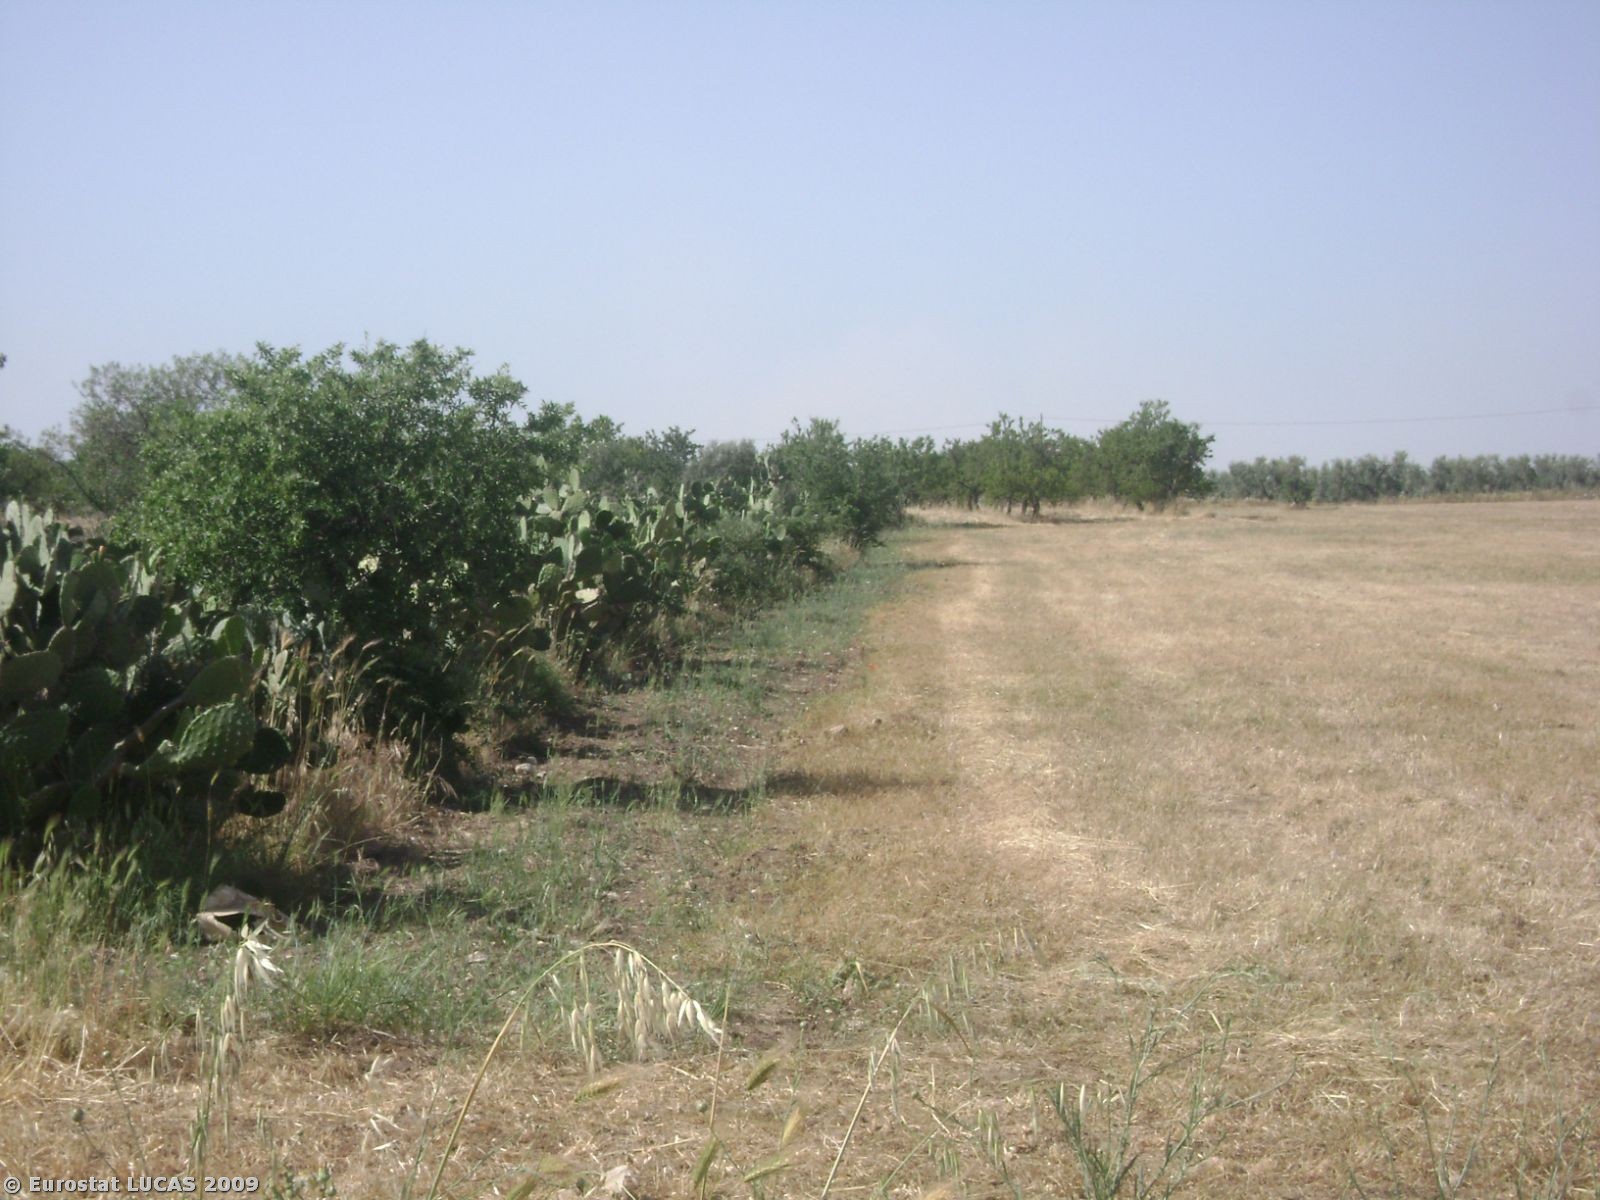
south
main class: Cropland
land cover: Durum wheat
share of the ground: > 75 %
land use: Agriculture (excluding fallow land and kitchen gardens)
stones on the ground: 10 - 25 %
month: May
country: IT
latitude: 41.6239
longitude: 15.7076
